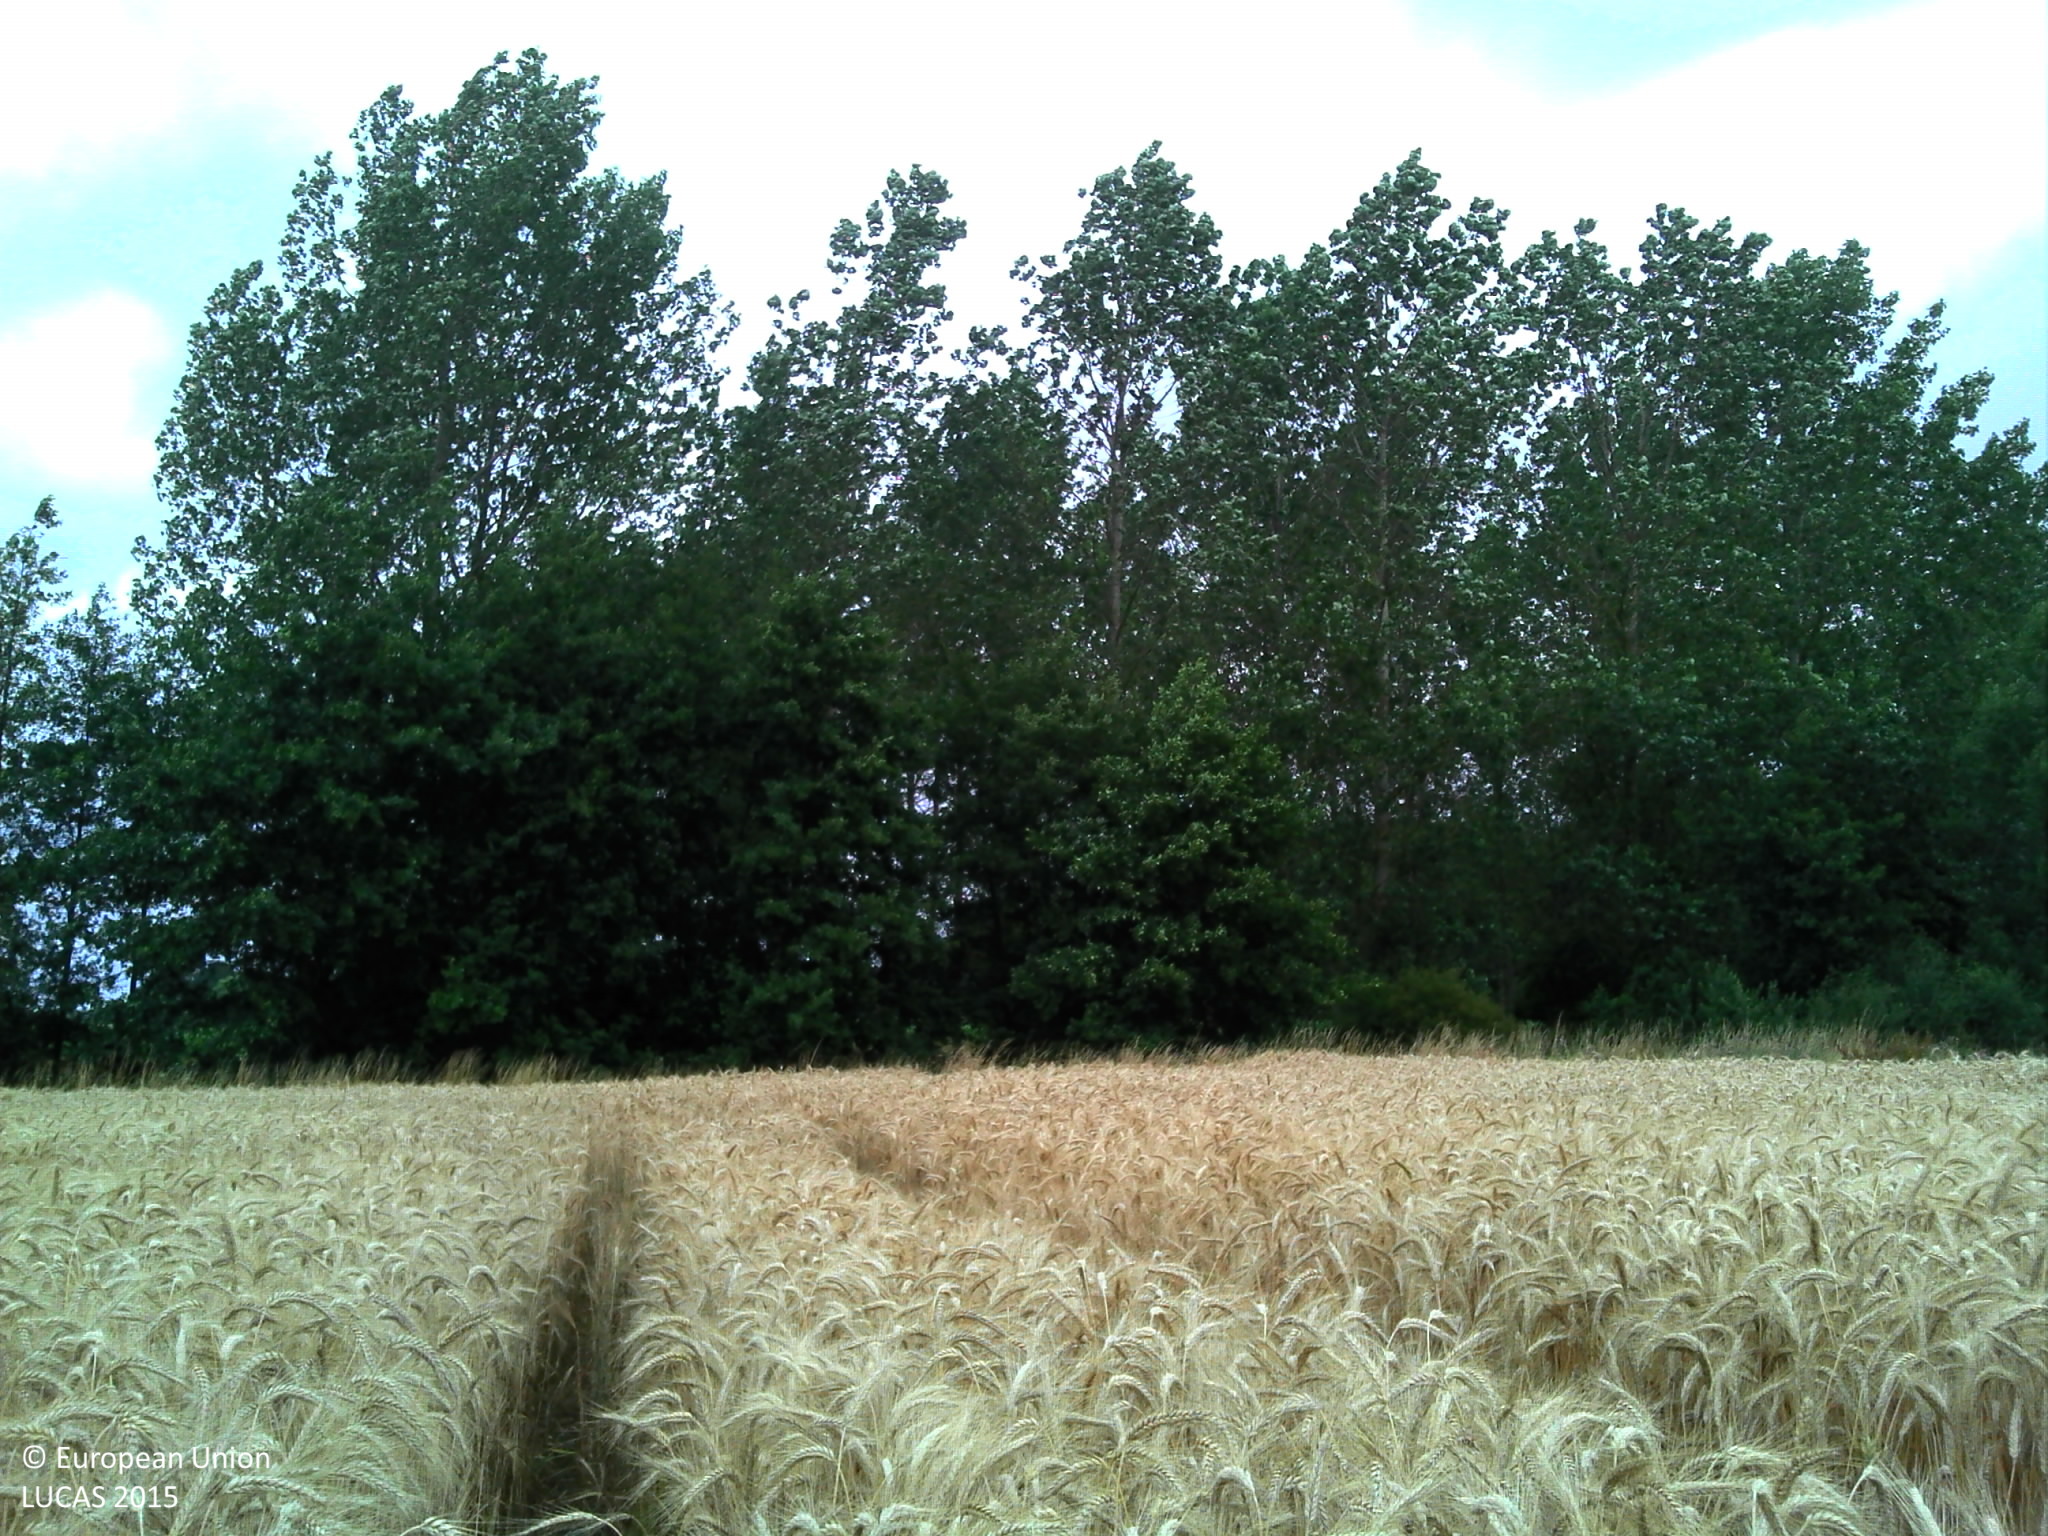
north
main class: Cropland
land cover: Triticale
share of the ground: > 75 %
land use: Agriculture (excluding fallow land and kitchen gardens)
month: July
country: FR
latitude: 50.4480
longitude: 3.1606
